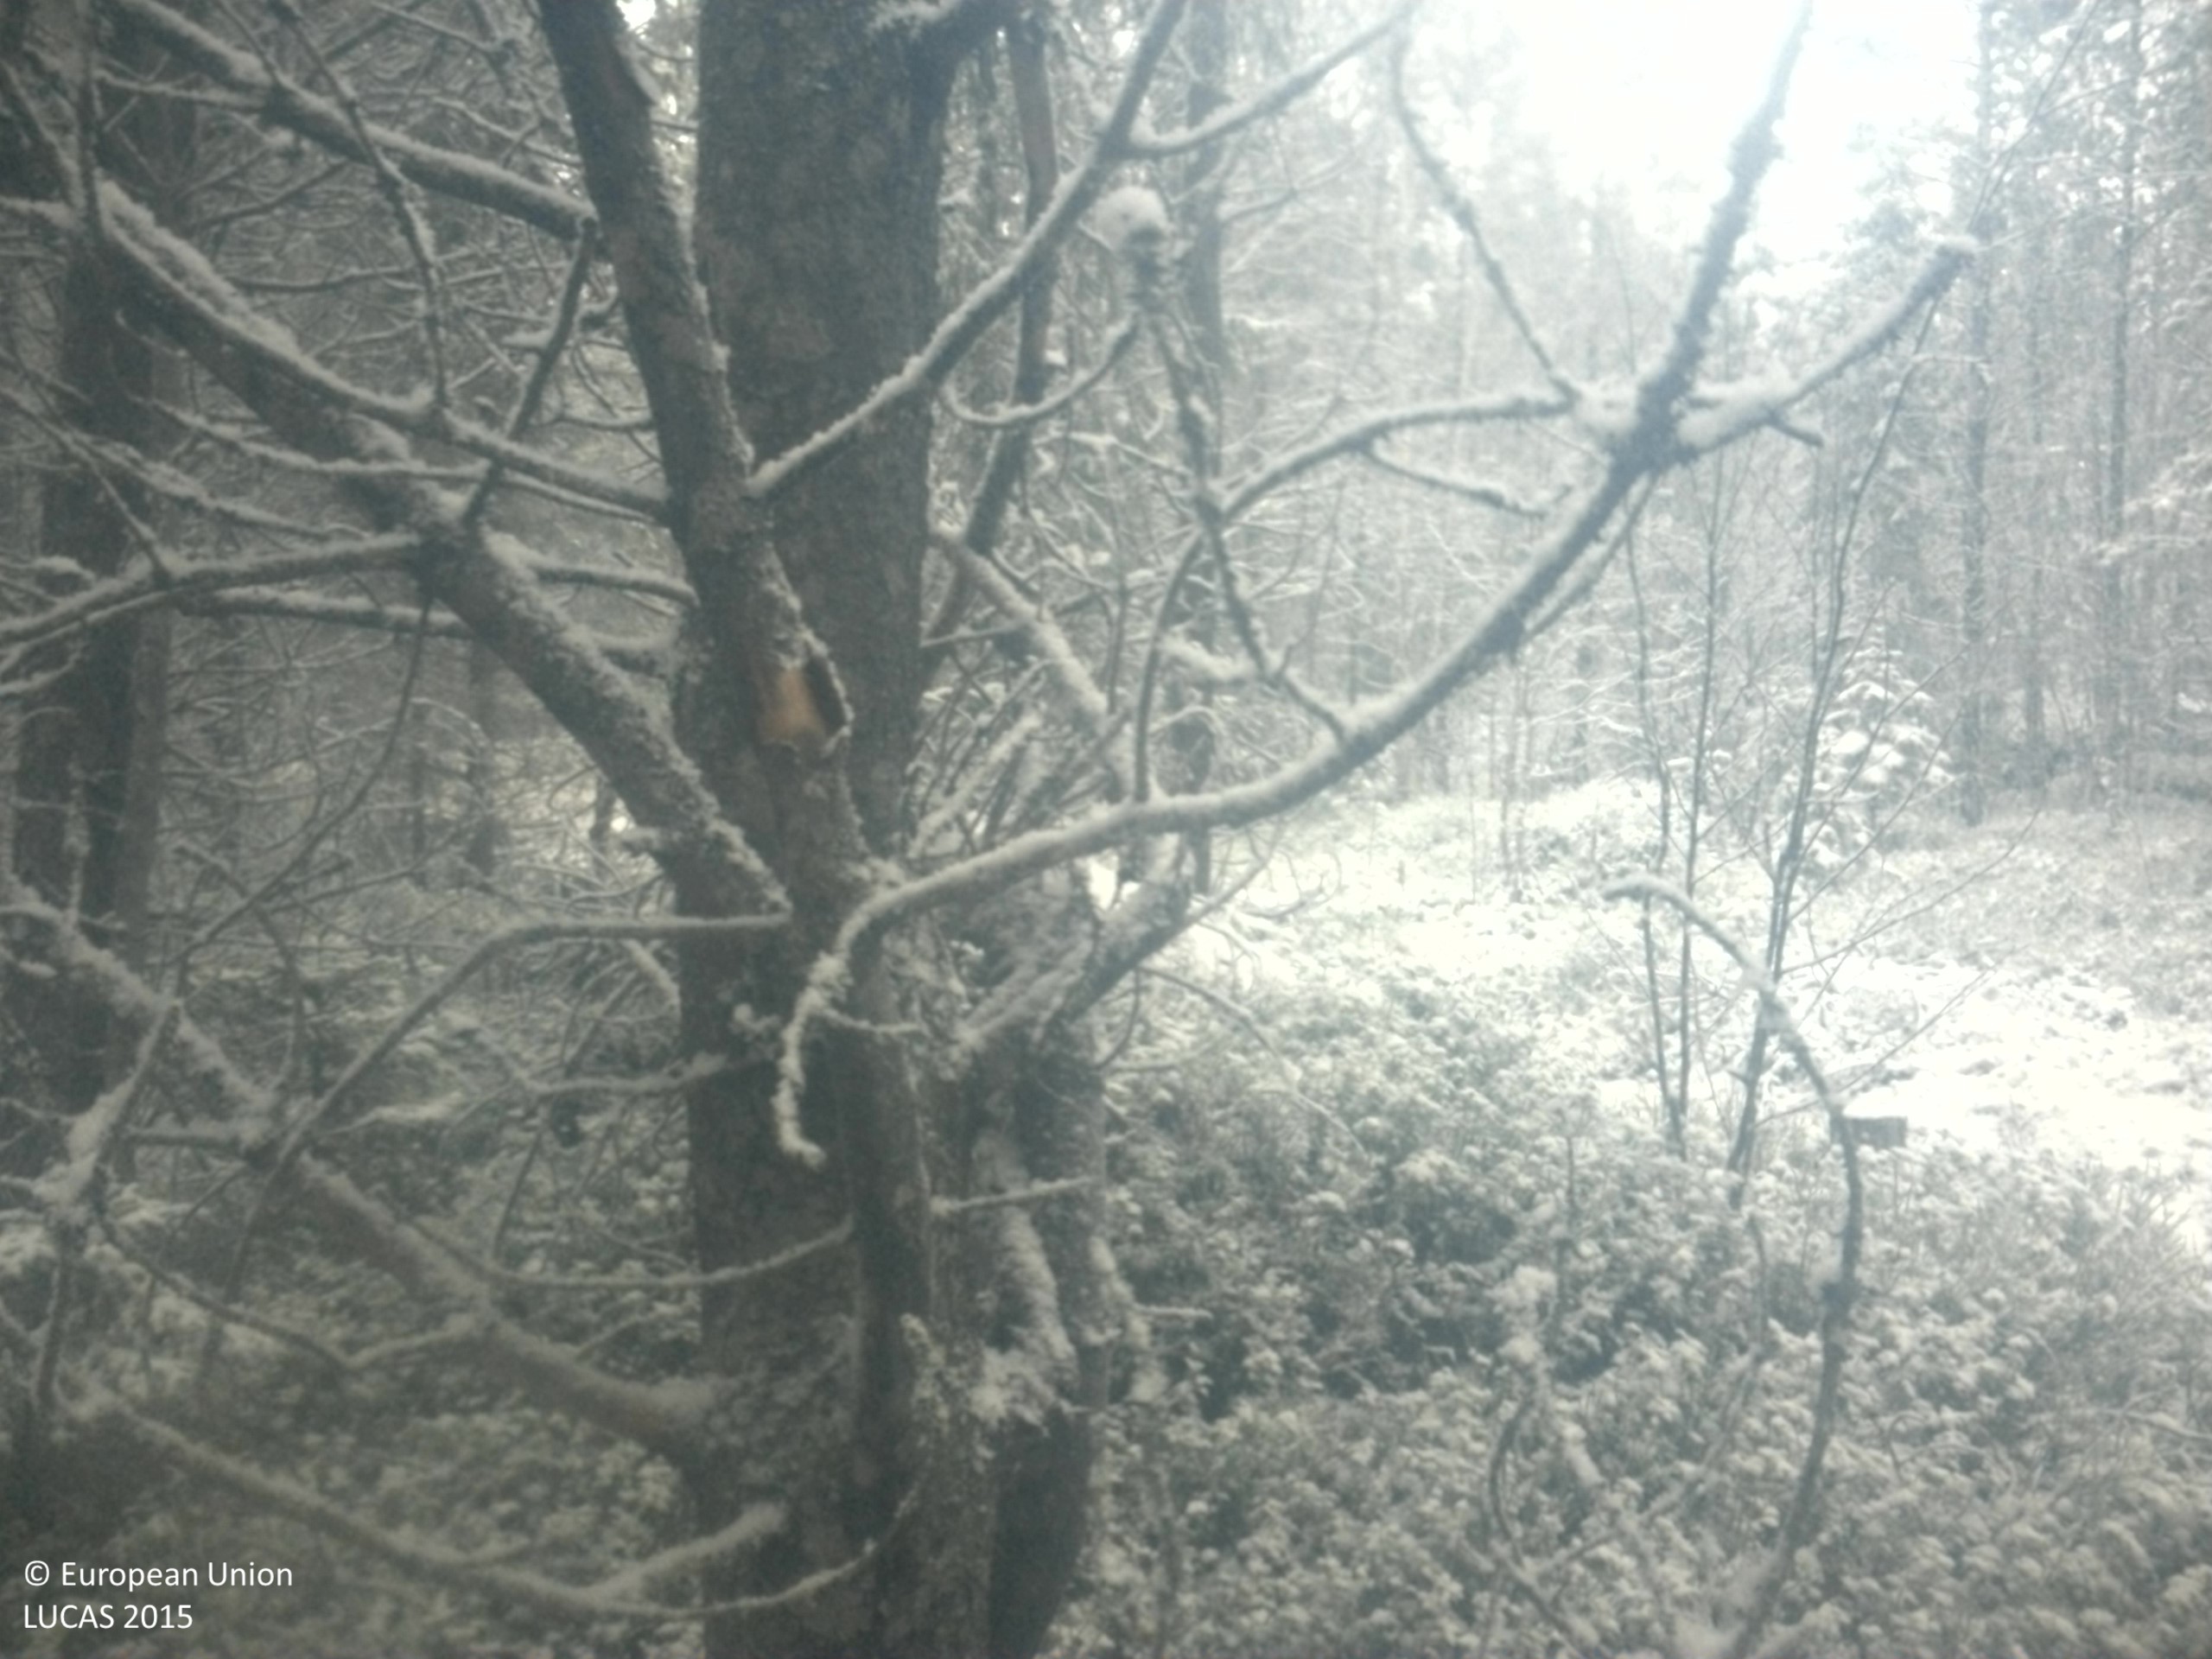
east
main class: Woodland
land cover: Pine dominated mixed woodland
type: exotic forest
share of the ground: 50 - 75 %
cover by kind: coniferous forest trees 45 %, shrubs 20 %, broadleaved forest trees 15 %, lichens and mosses 15 %, herbaceous plants 5 %
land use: Forestry
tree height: > 5 m
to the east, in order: Pine dominated mixed woodland; Tracks; Pine dominated mixed woodland; Broadleaved woodland; Shruby margins; Paved roads, cycling and walking lanes; Shruby margins; Pine dominated mixed woodland; Pine dominated coniferous woodland
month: November
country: SE
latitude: 63.7269
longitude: 15.9061
